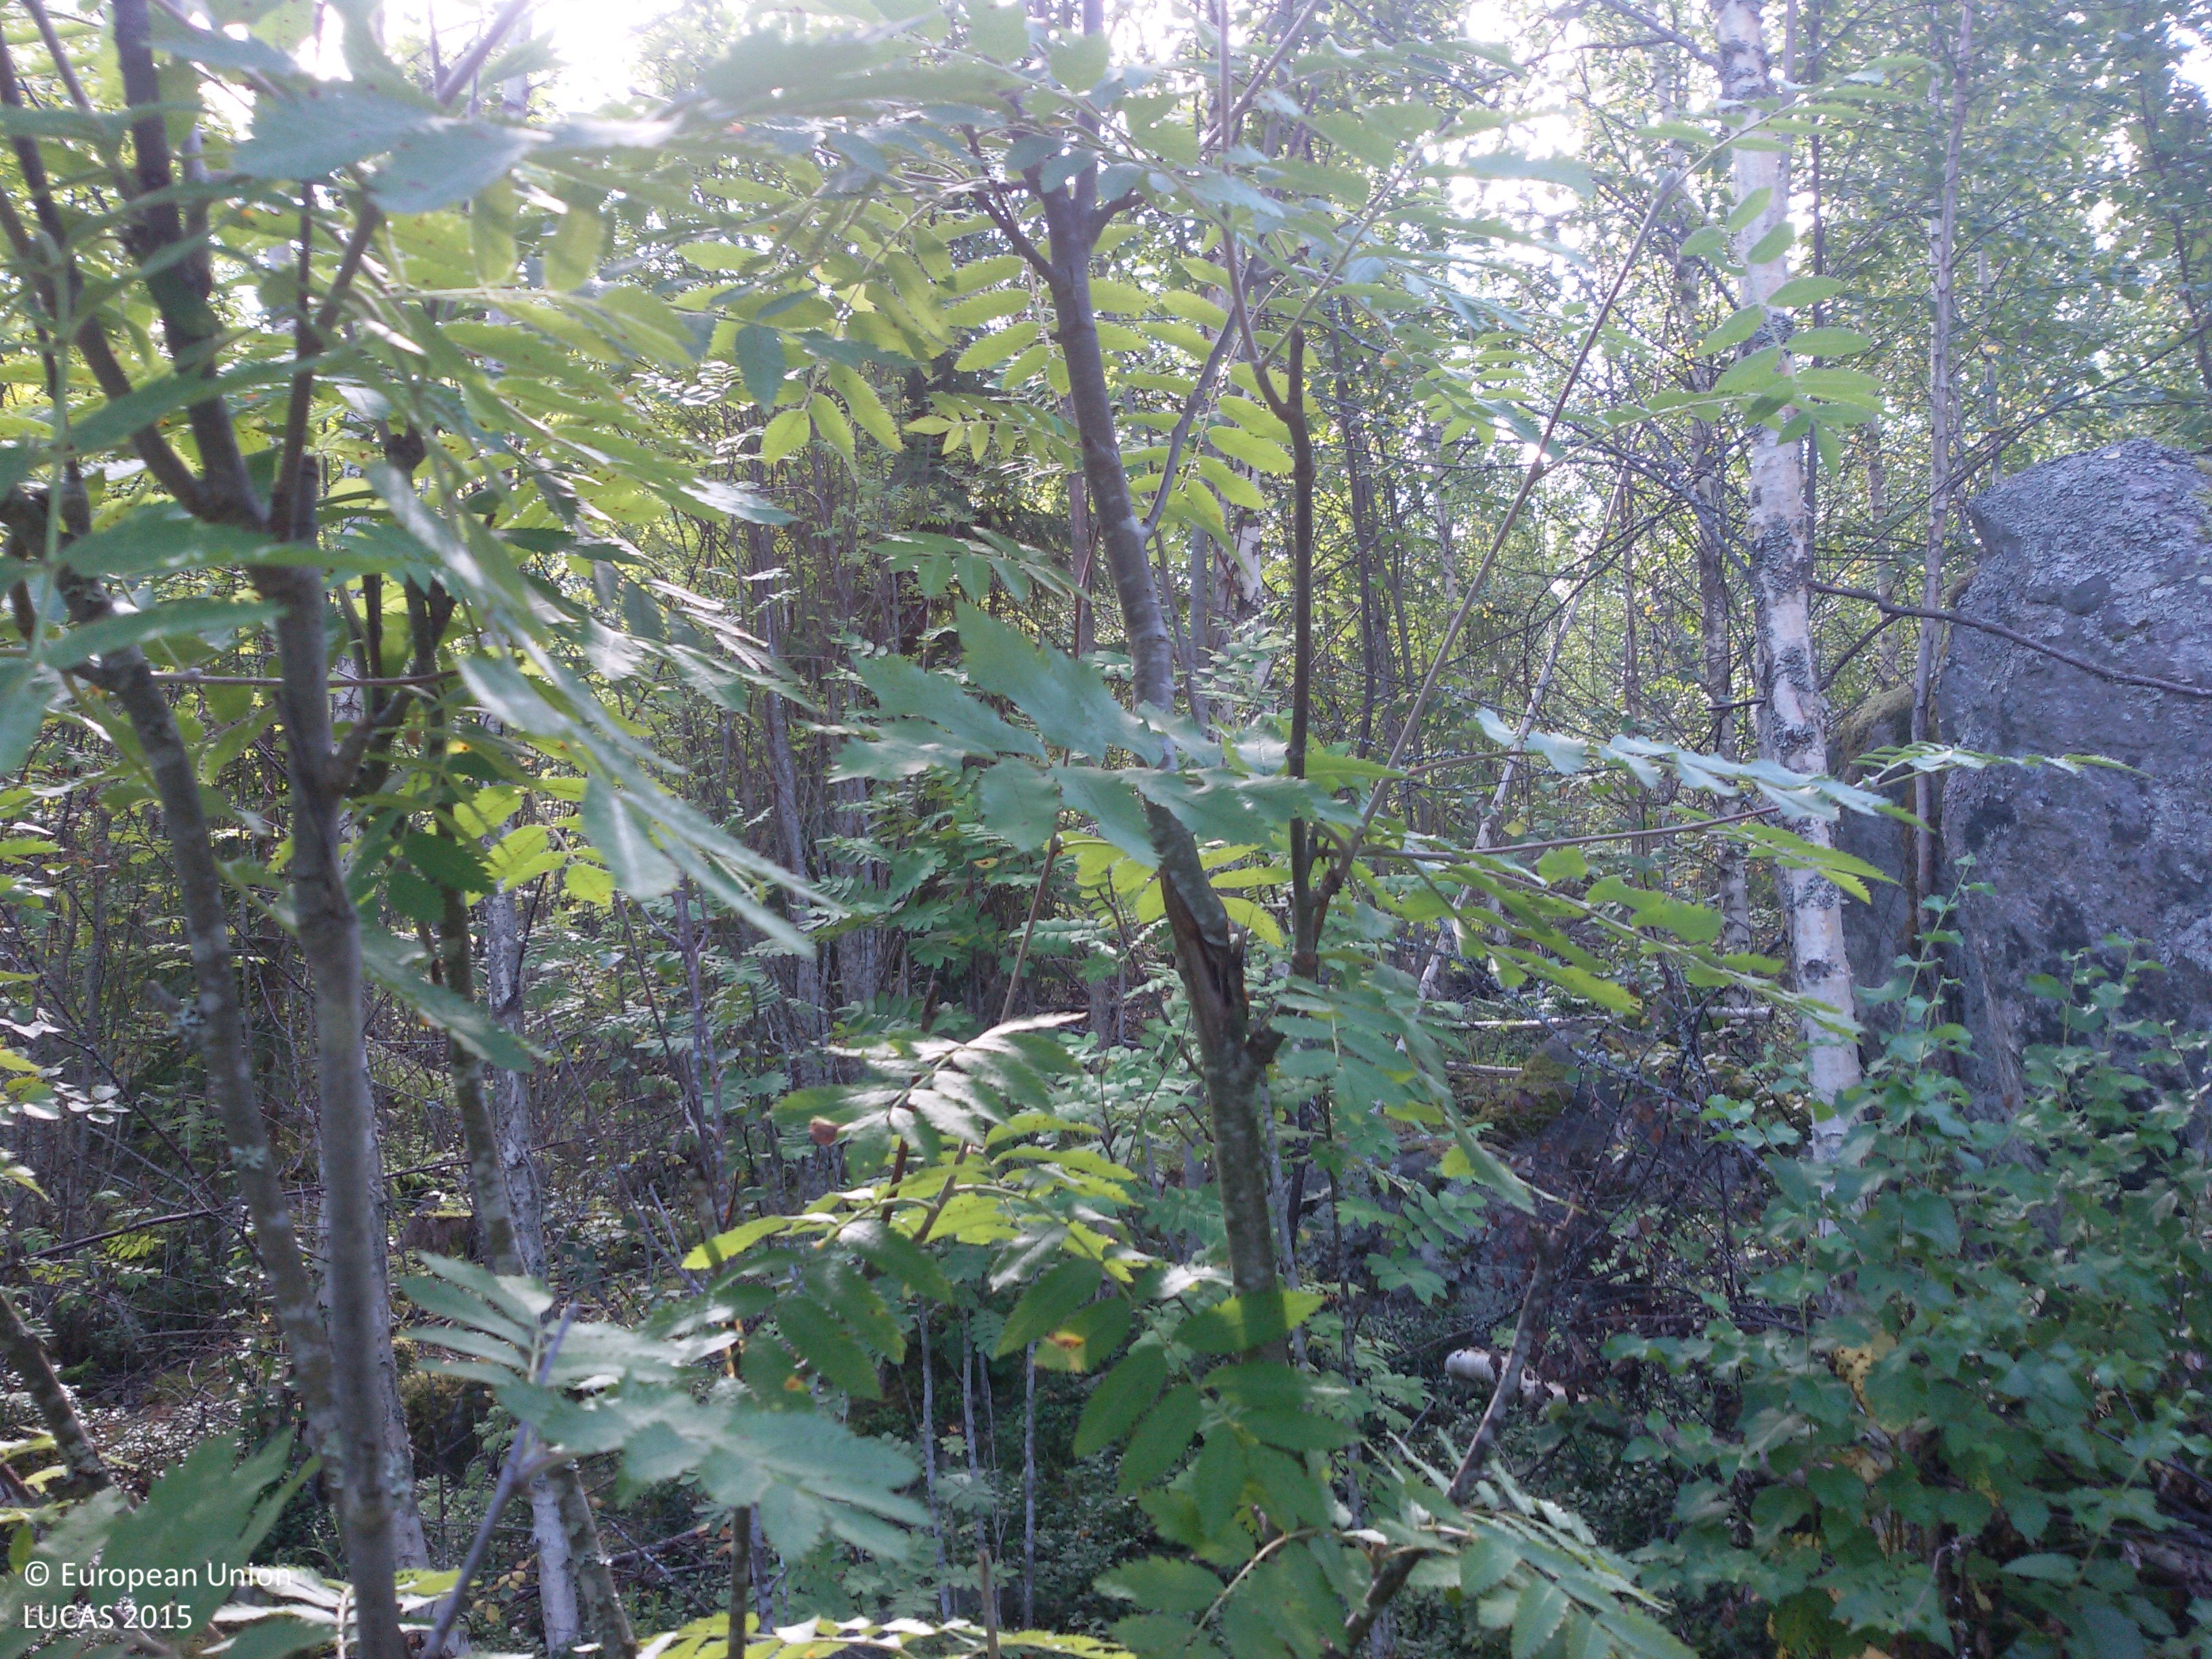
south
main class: Woodland
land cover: Broadleaved woodland
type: boreal forest
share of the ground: 50 - 75 %
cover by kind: broadleaved forest trees 65 %, herbaceous plants 15 %, lichens and mosses 15 %, coniferous forest trees 5 %
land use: Forestry
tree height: > 5 m
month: August
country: SE
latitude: 60.7610
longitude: 15.9149
